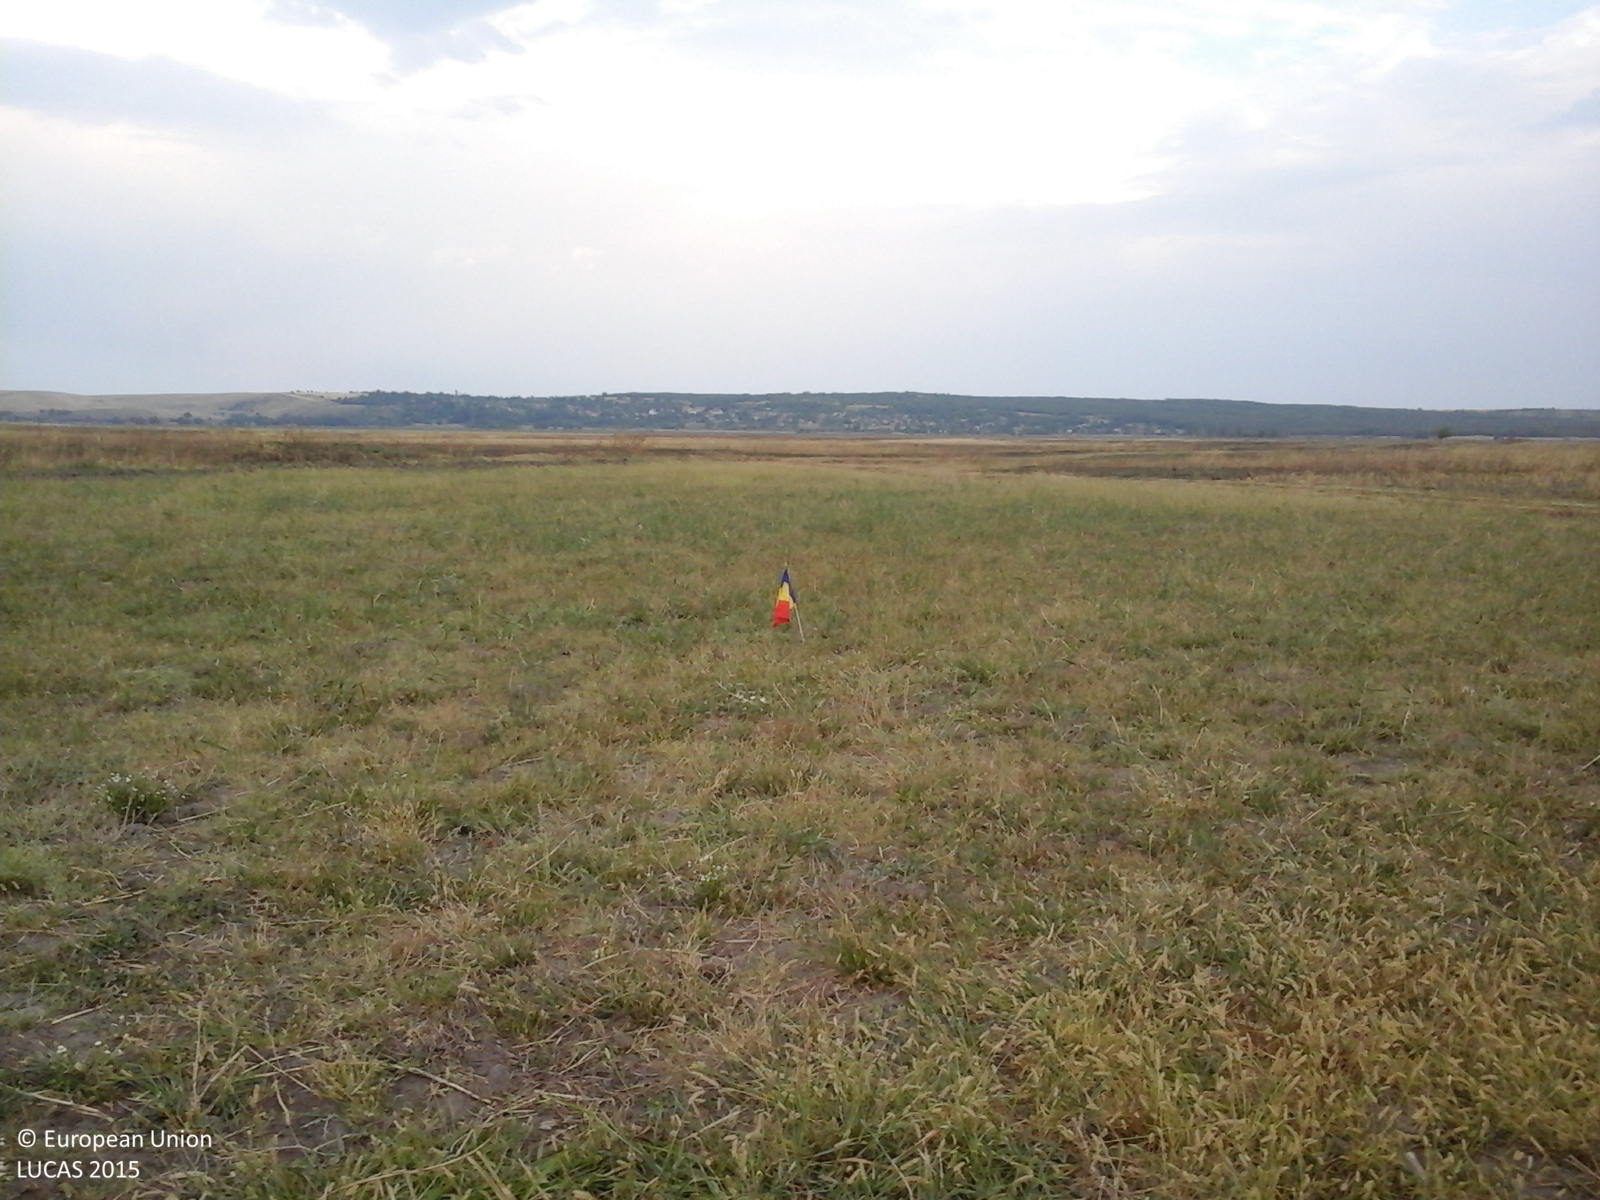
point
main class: Grassland
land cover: Grassland without tree/shrub cover
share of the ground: > 75 %
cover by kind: herbaceous plants 100 %
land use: Agriculture (excluding fallow land and kitchen gardens)
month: August
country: RO
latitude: 44.3745
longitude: 22.8051
